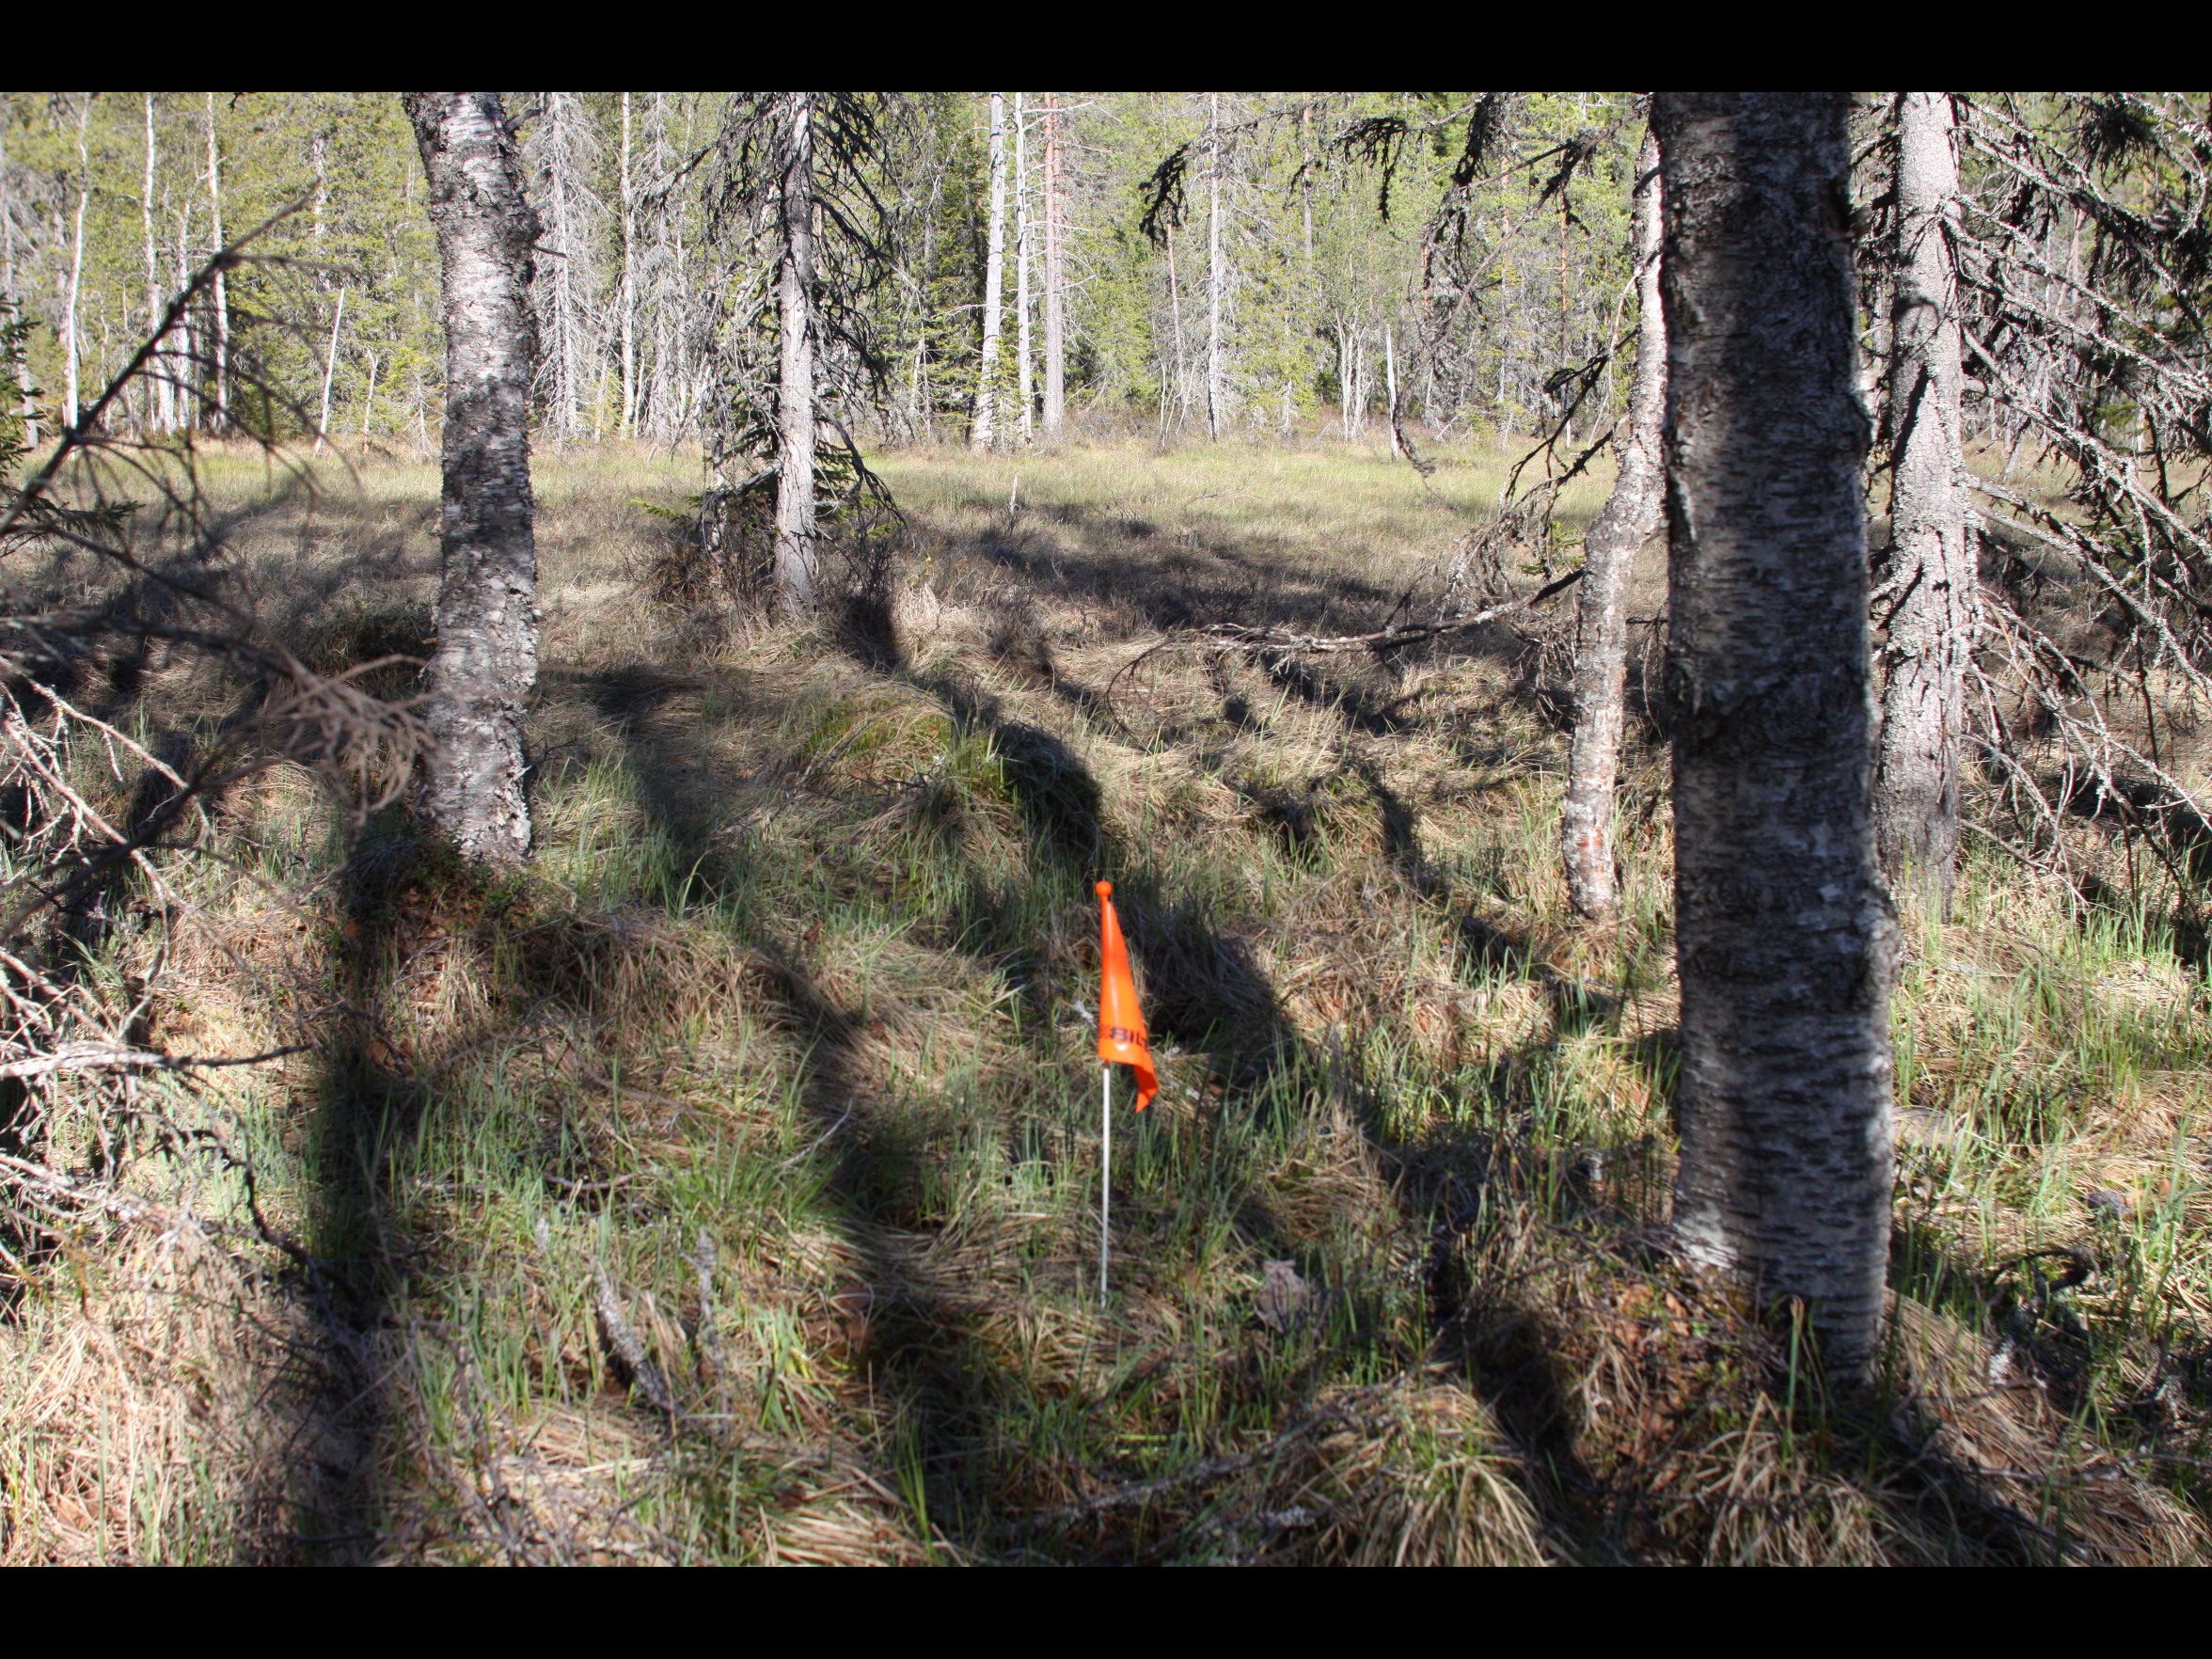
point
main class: Woodland
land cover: Spruce dominated mixed woodland
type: boreal forest
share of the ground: > 75 %
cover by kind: coniferous forest trees 45 %, broadleaved forest trees 35 %, herbaceous plants 10 %, lichens and mosses 10 %
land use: Forestry
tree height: > 5 m
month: June
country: FI
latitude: 66.2462
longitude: 27.4936
